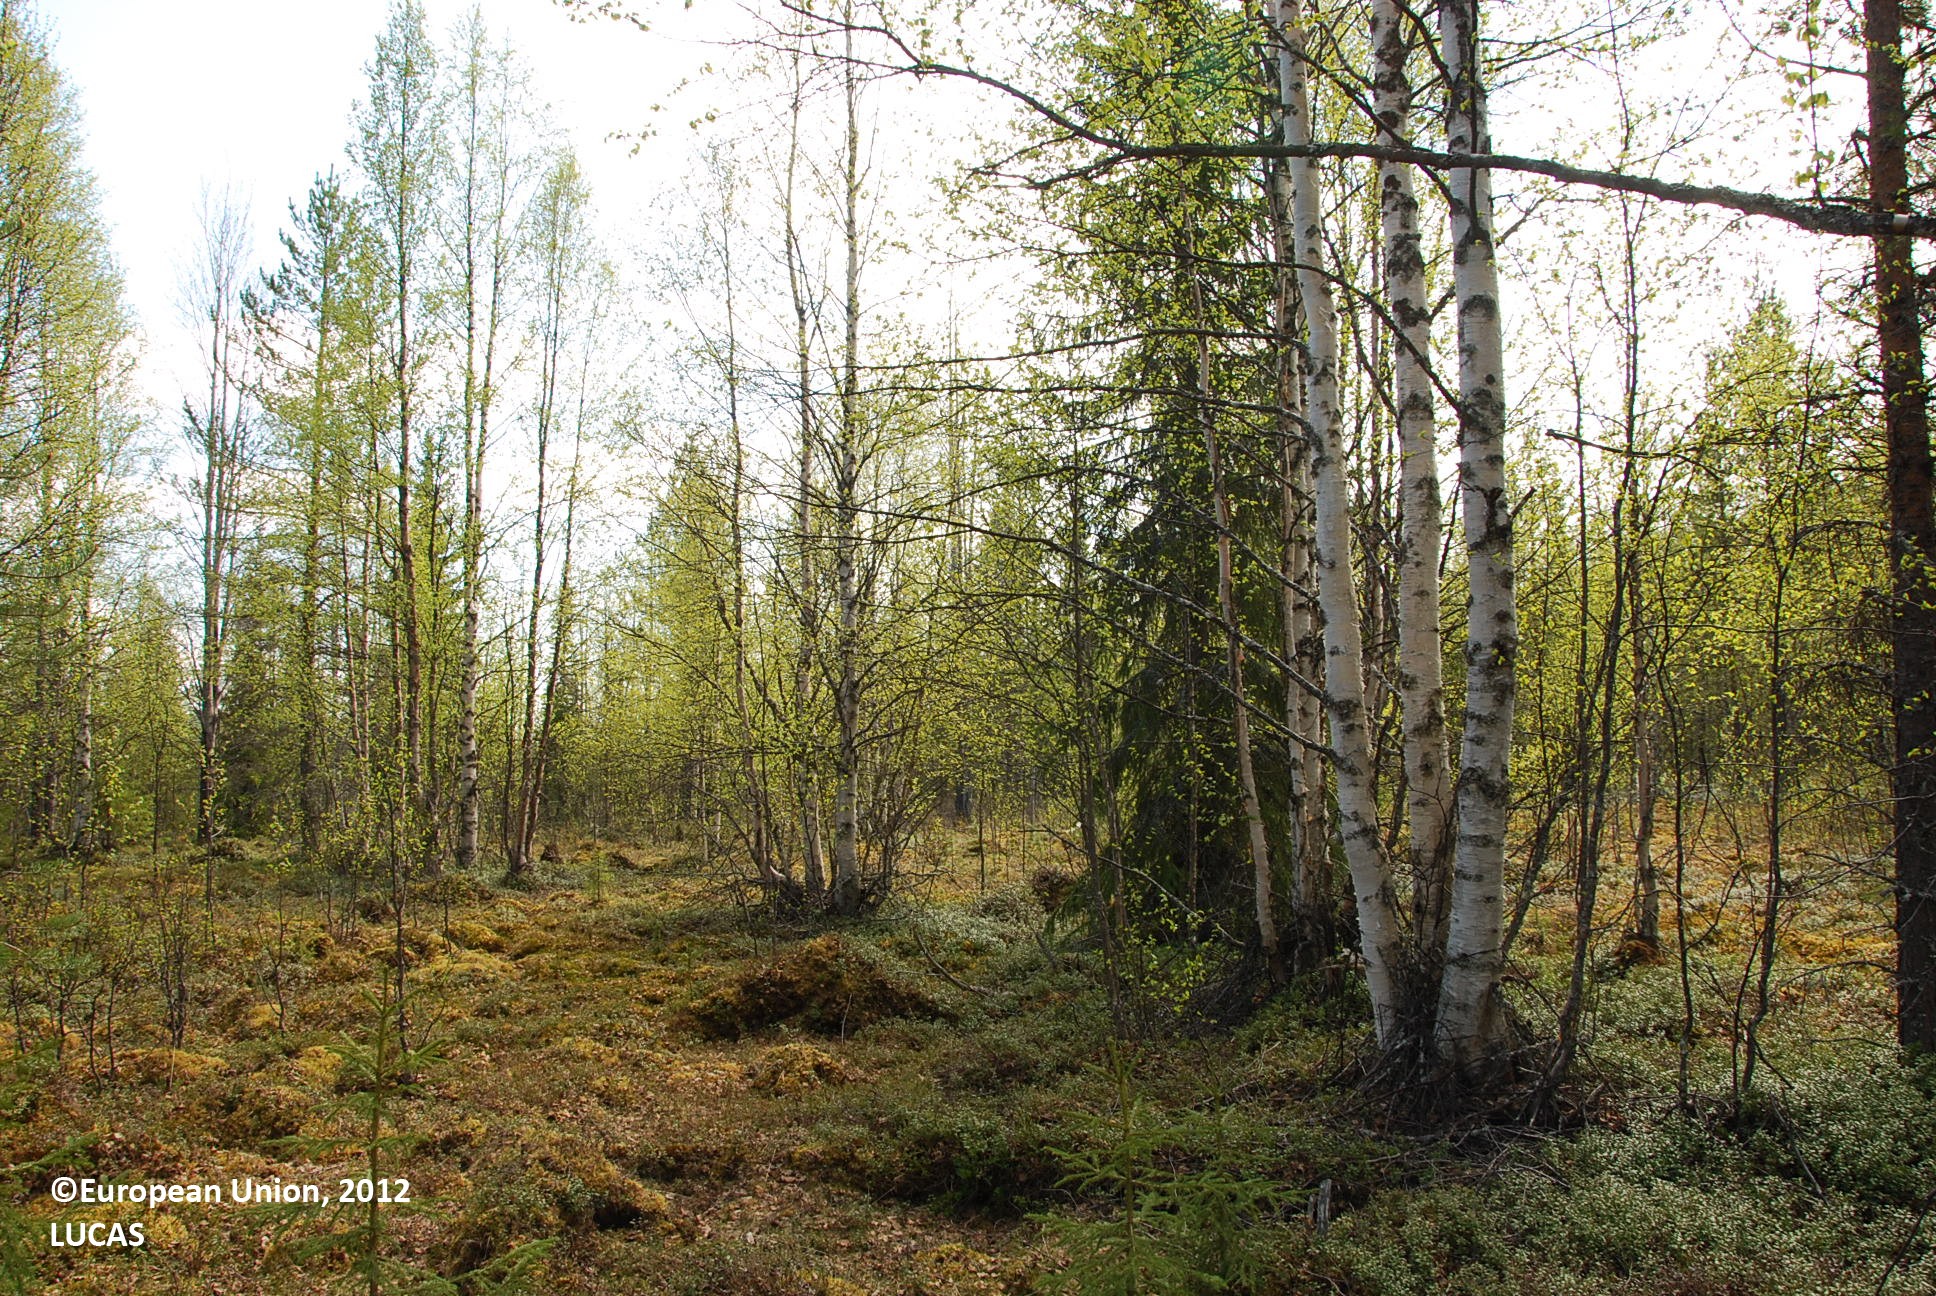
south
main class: Woodland
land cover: Broadleaved woodland
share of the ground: 50 - 75 %
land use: Forestry
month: June
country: FI
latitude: 66.9529
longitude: 28.2357
